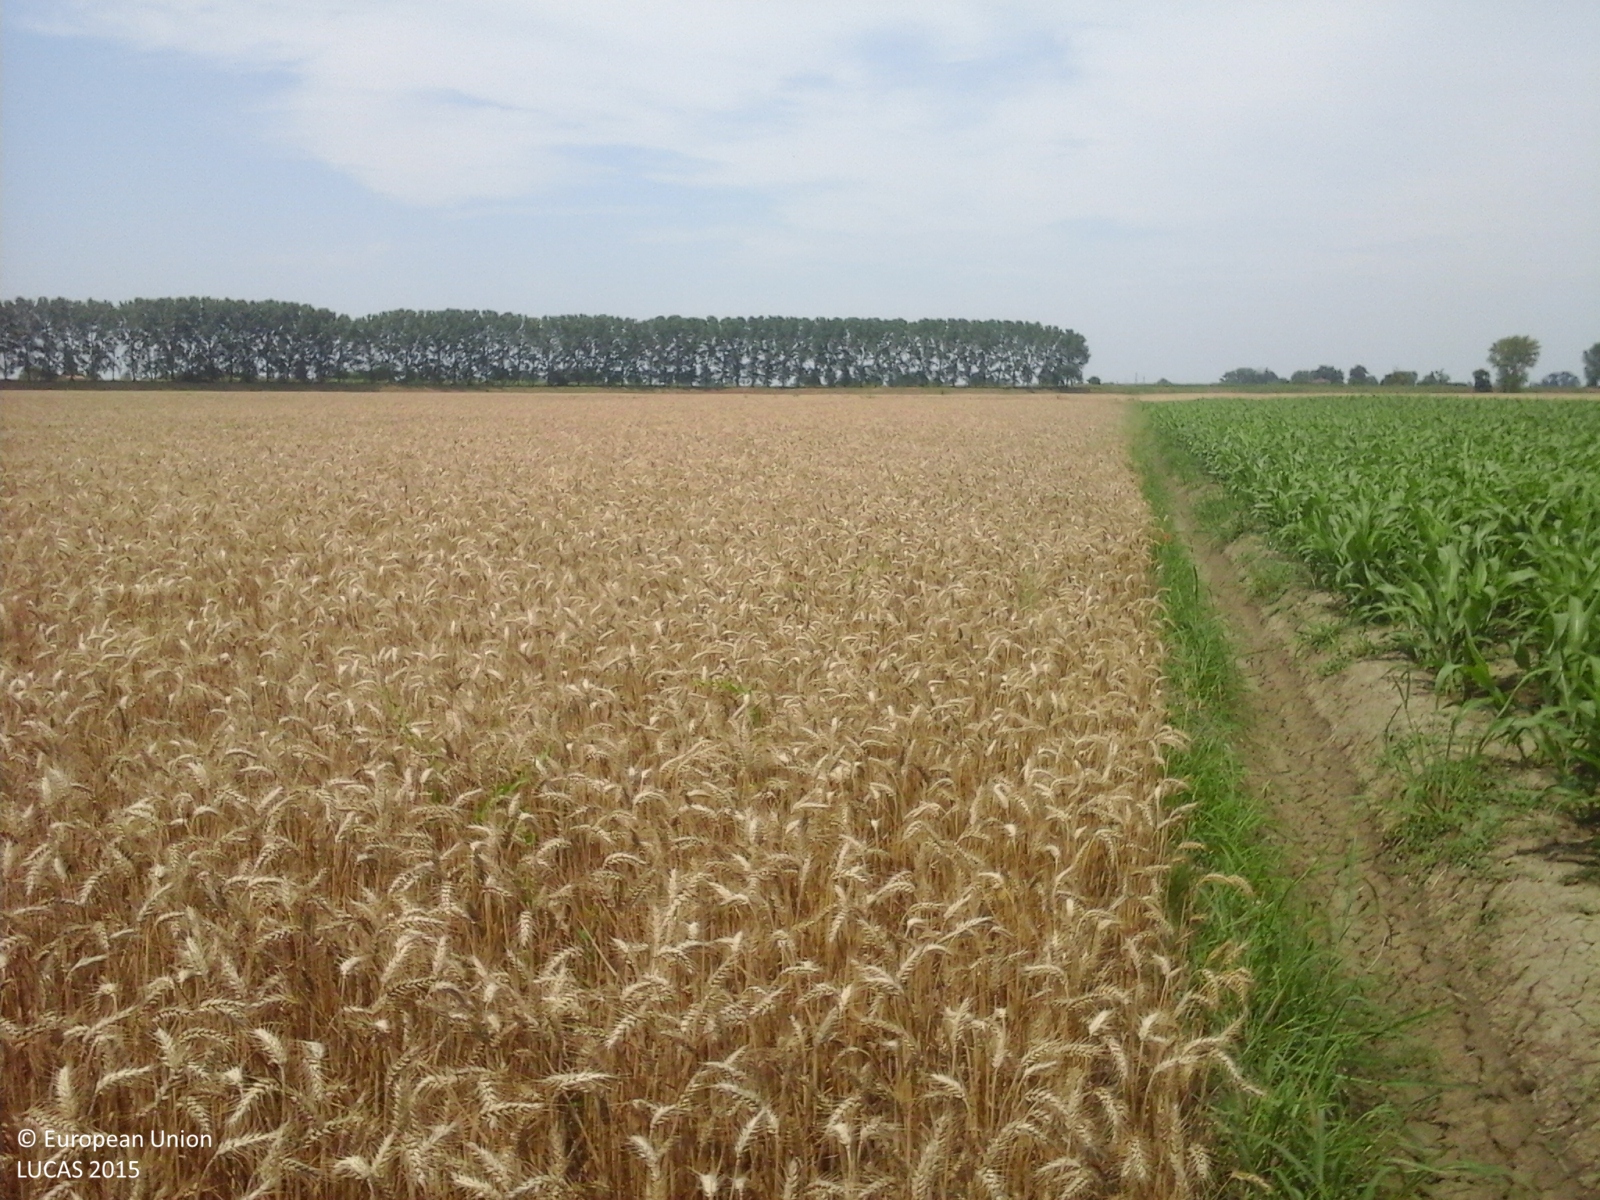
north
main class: Cropland
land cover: Common wheat
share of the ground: > 75 %
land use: Agriculture (excluding fallow land and kitchen gardens)
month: June
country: IT
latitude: 44.6872
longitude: 11.1206
